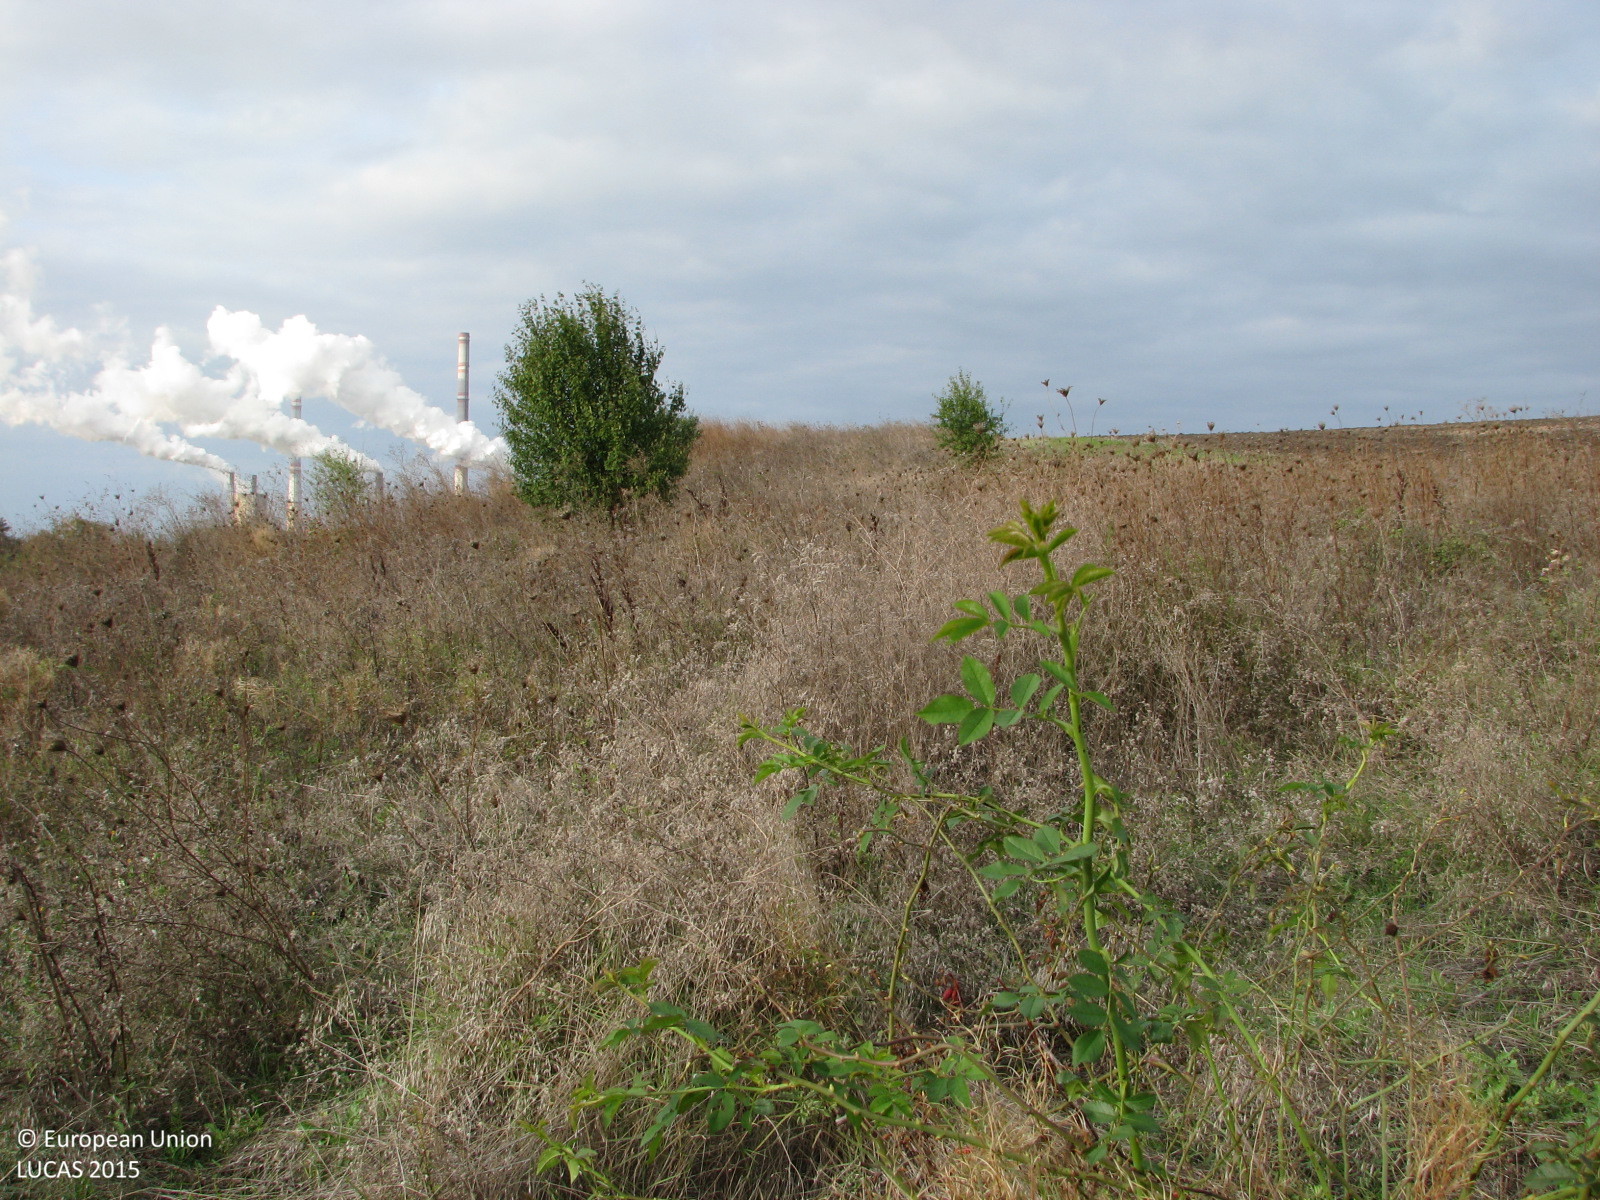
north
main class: Grassland
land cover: Grassland without tree/shrub cover
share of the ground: > 75 %
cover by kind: herbaceous plants 95 %, shrubs 5 %
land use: Agriculture (excluding fallow land and kitchen gardens)
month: October
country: BG
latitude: 42.2326
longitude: 26.1355
